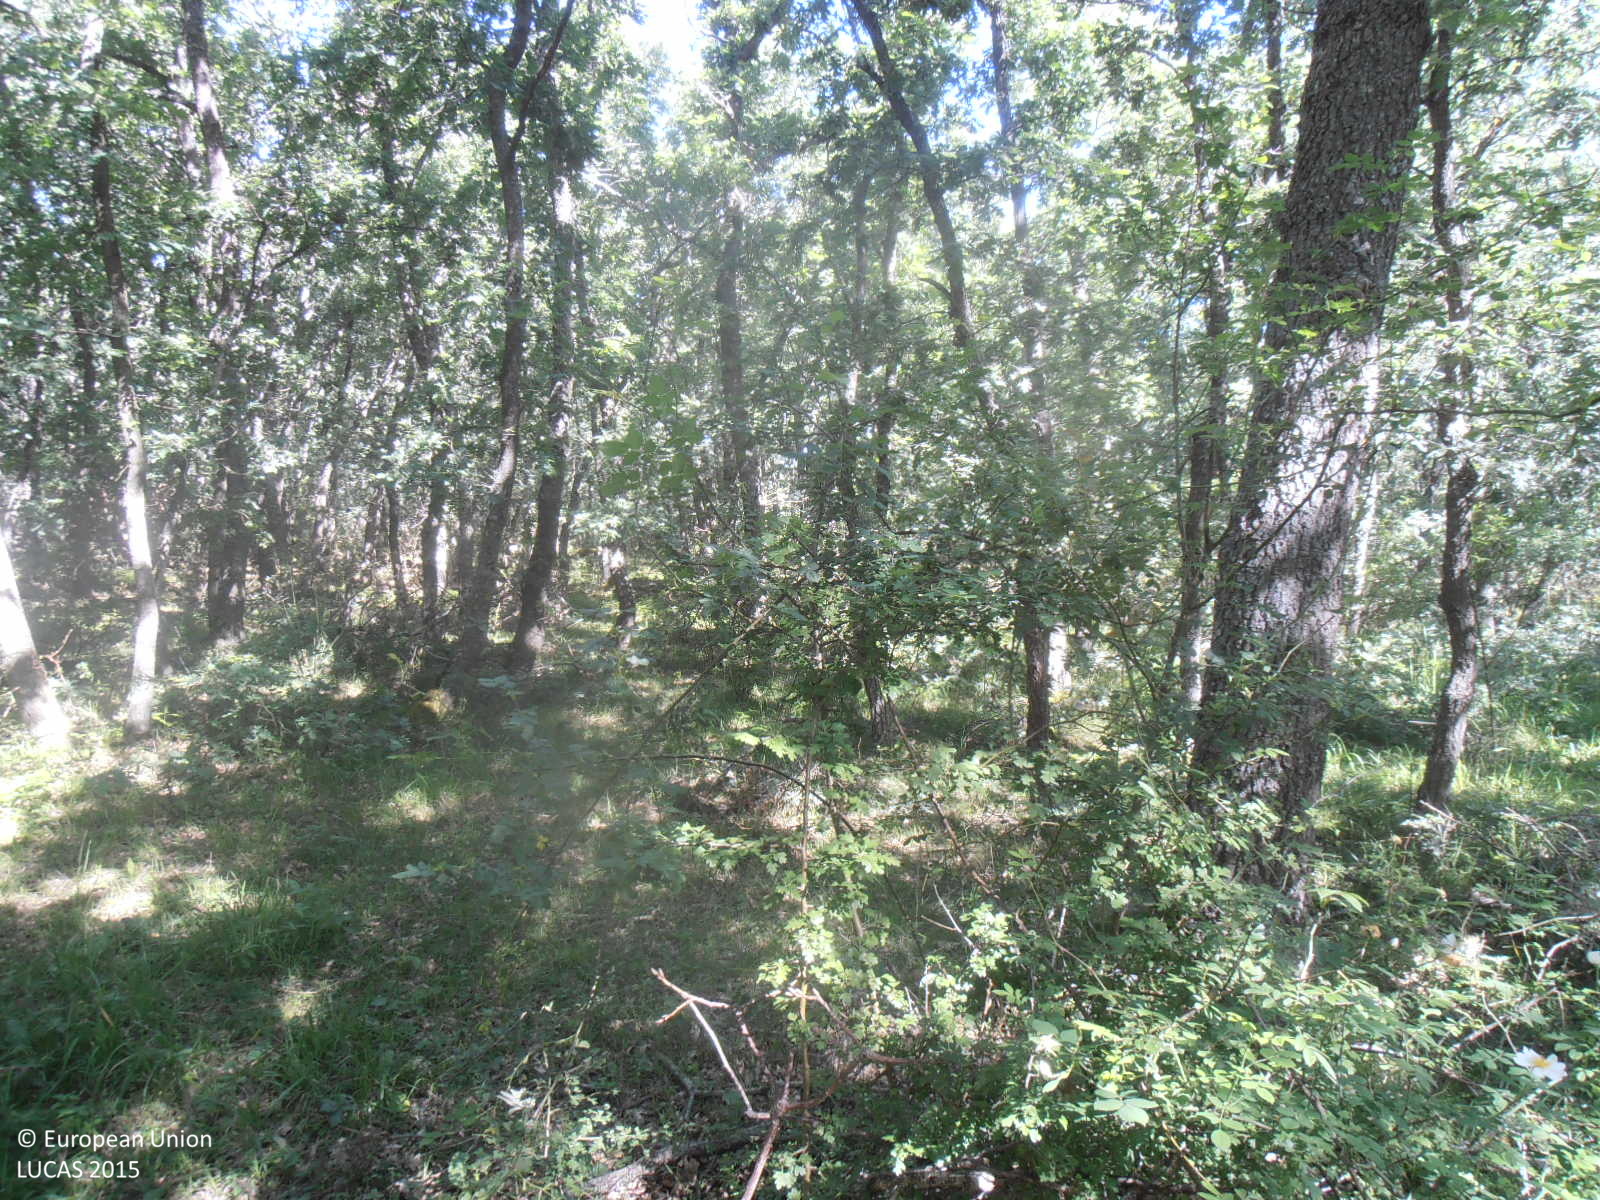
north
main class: Woodland
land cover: Broadleaved woodland
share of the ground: > 75 %
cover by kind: broadleaved forest trees 90 %, herbaceous plants 10 %
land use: Semi-natural and natural areas not in use
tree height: < 5 m
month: June
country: ES
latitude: 41.7584
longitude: -1.9758
